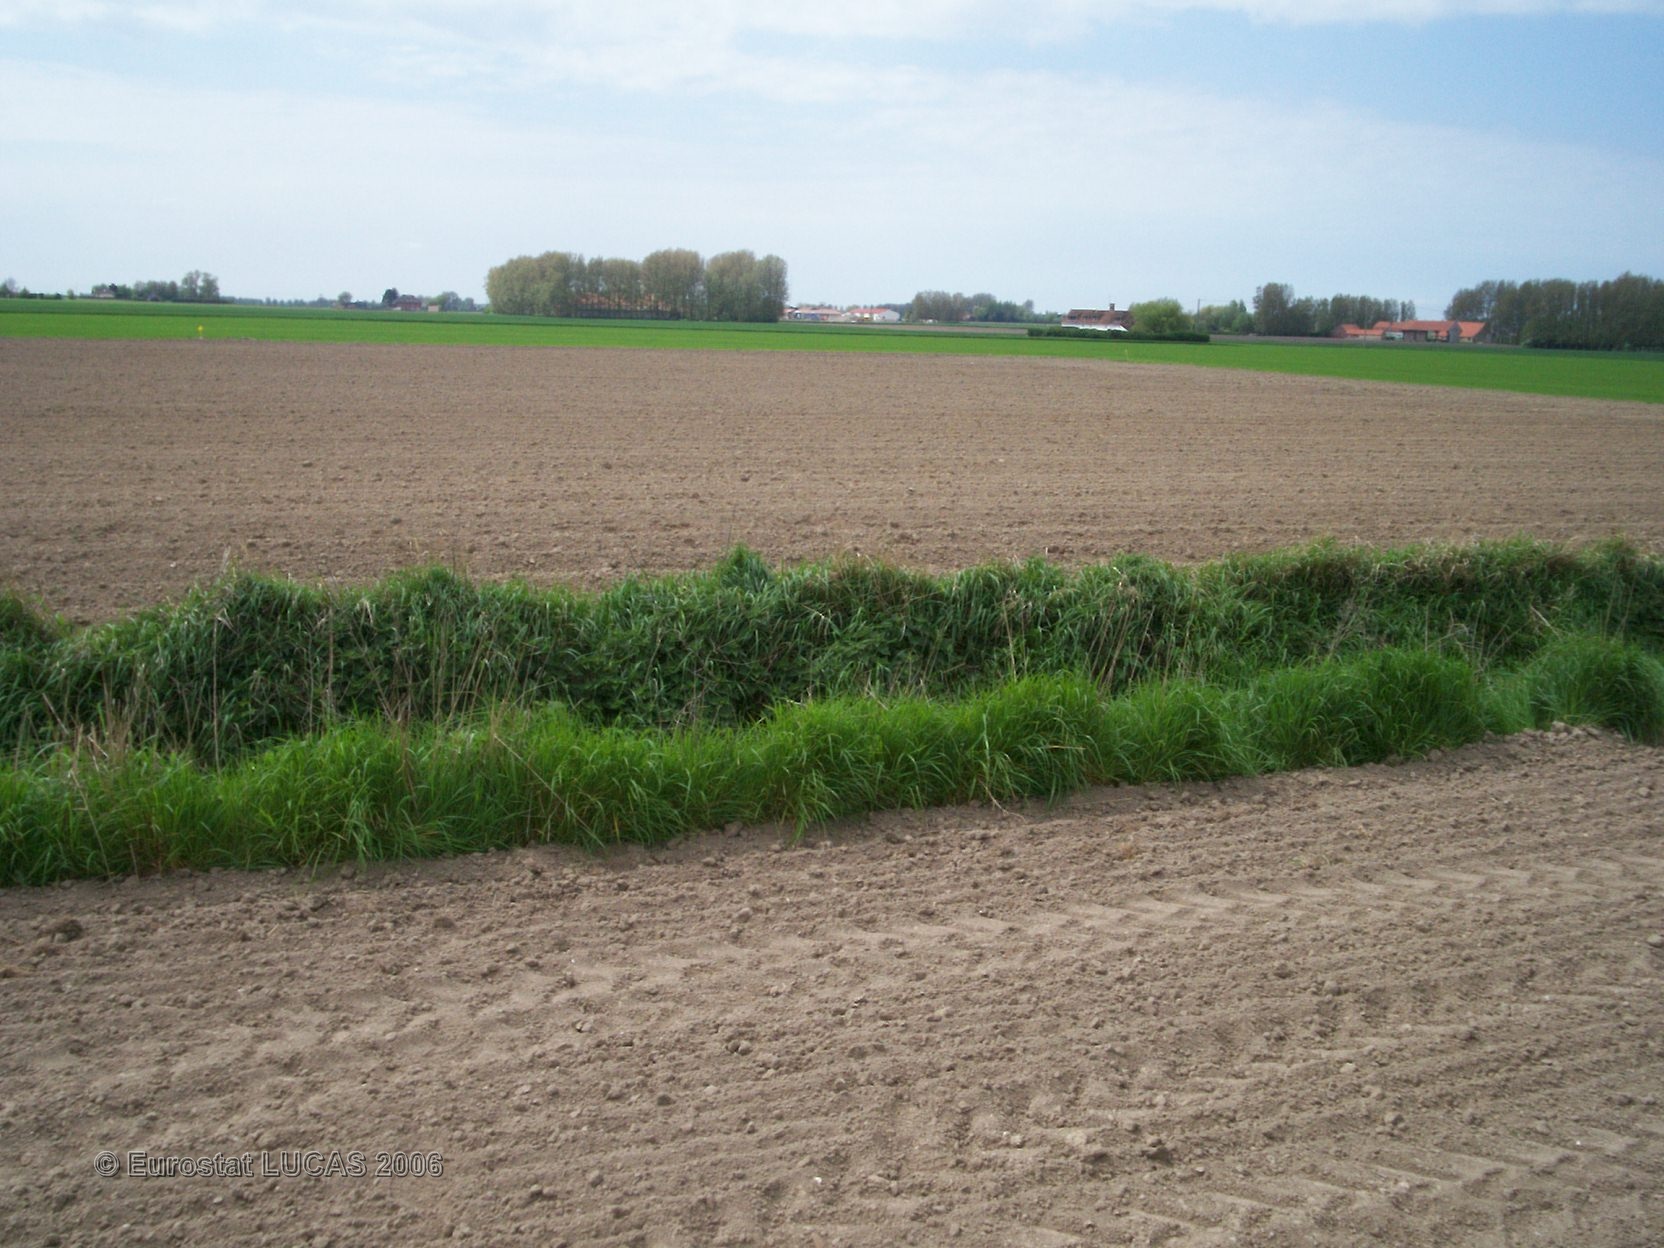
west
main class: Grassland
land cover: Grassland without tree/shrub cover
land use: Agriculture (excluding fallow land and kitchen gardens)
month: May
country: FR
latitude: 50.9382
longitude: 2.3444
